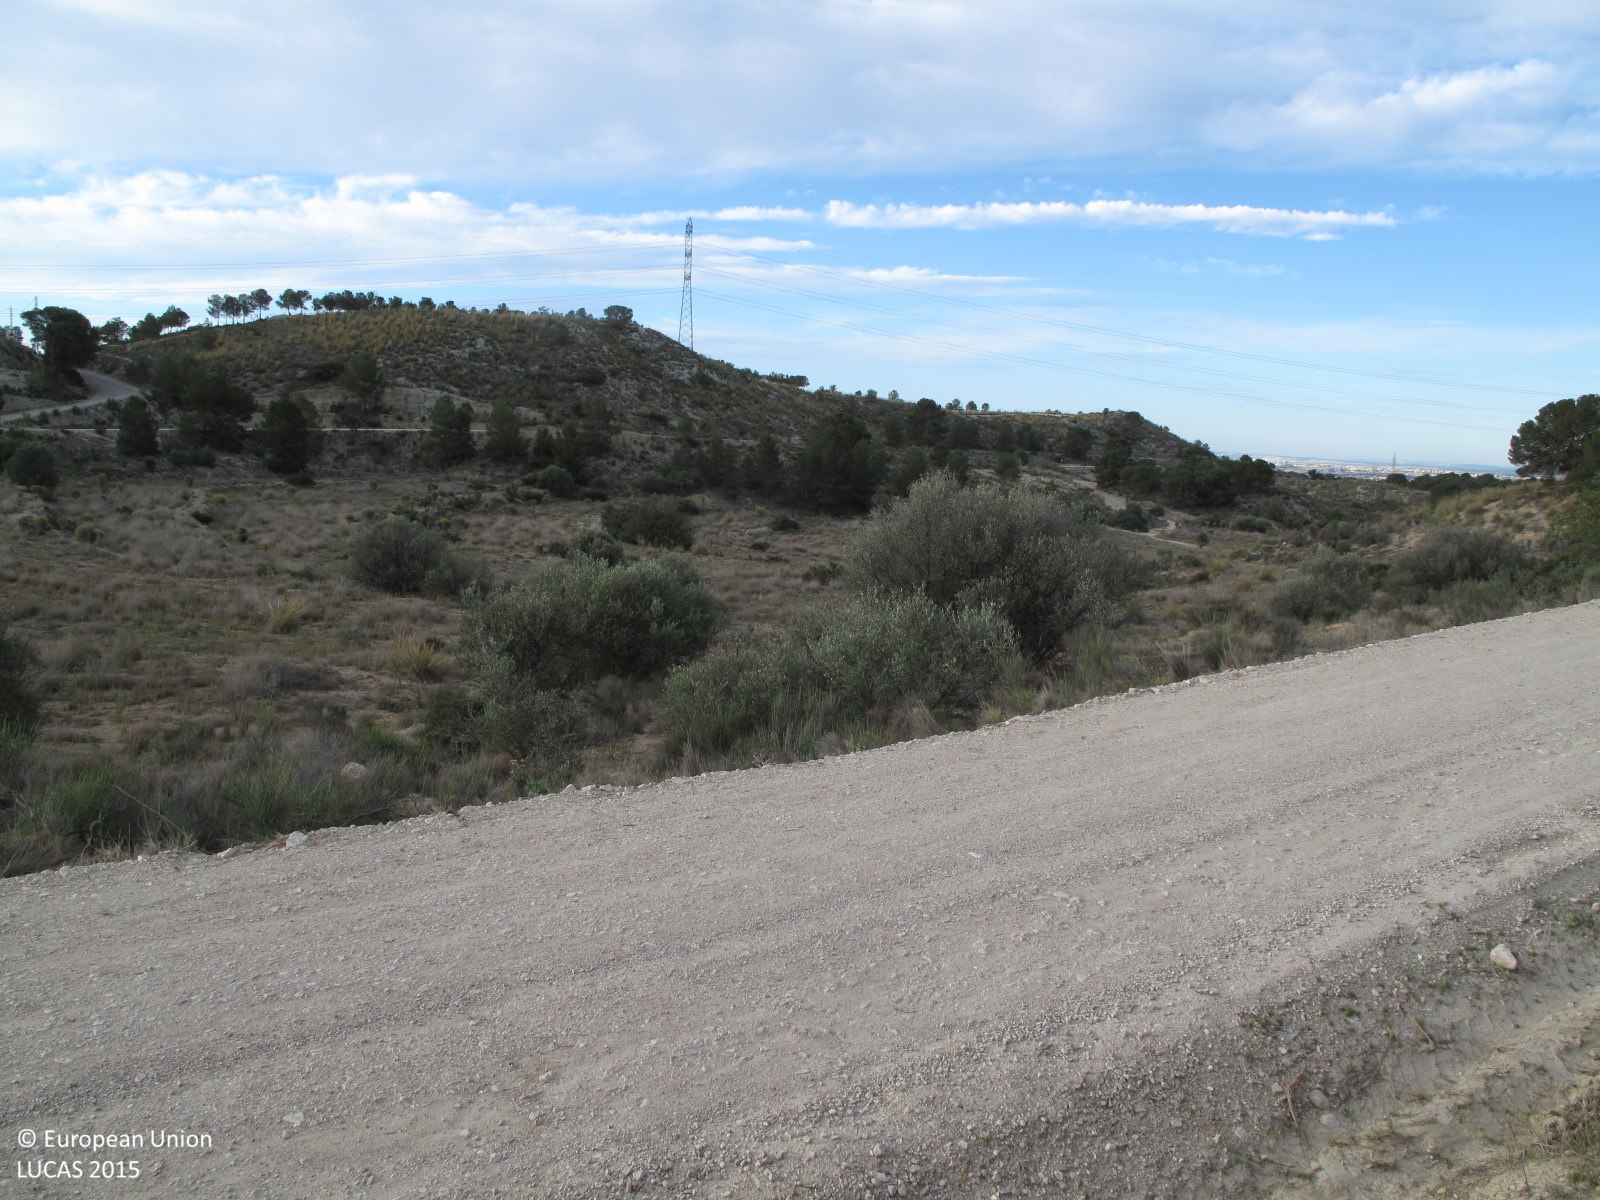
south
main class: Shrubland
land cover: Shrubland with sparse tree cover
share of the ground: 10 - 25 %
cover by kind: consolidated bare surface 60 %, herbaceous plants 20 %, shrubs 15 %, coniferous forest trees 5 %
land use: Abandoned areas
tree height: < 5 m
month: April
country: ES
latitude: 38.5054
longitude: -0.4337
